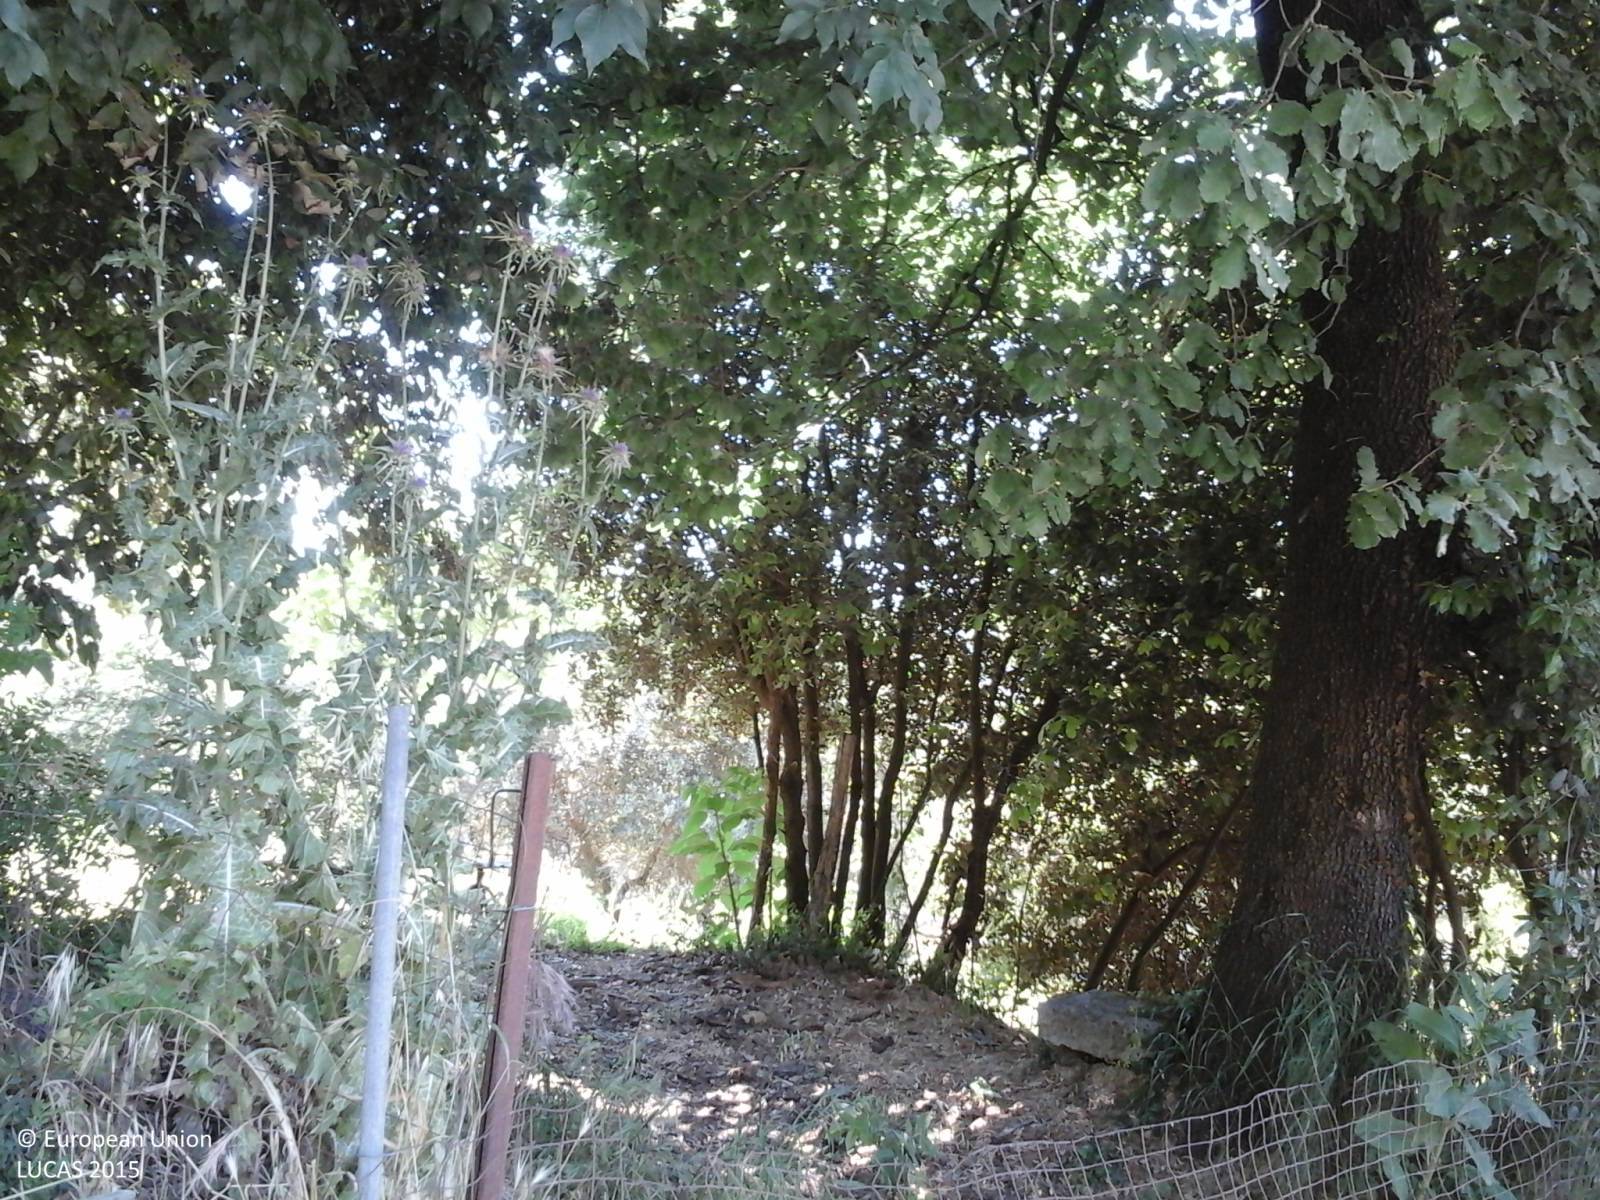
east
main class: Woodland
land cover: Broadleaved woodland
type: thermophilous deciduous forest
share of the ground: > 75 %
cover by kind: broadleaved forest trees 100 %
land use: Forestry
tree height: < 5 m
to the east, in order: Broadleaved woodland
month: June
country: IT
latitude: 41.3375
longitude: 14.1784
